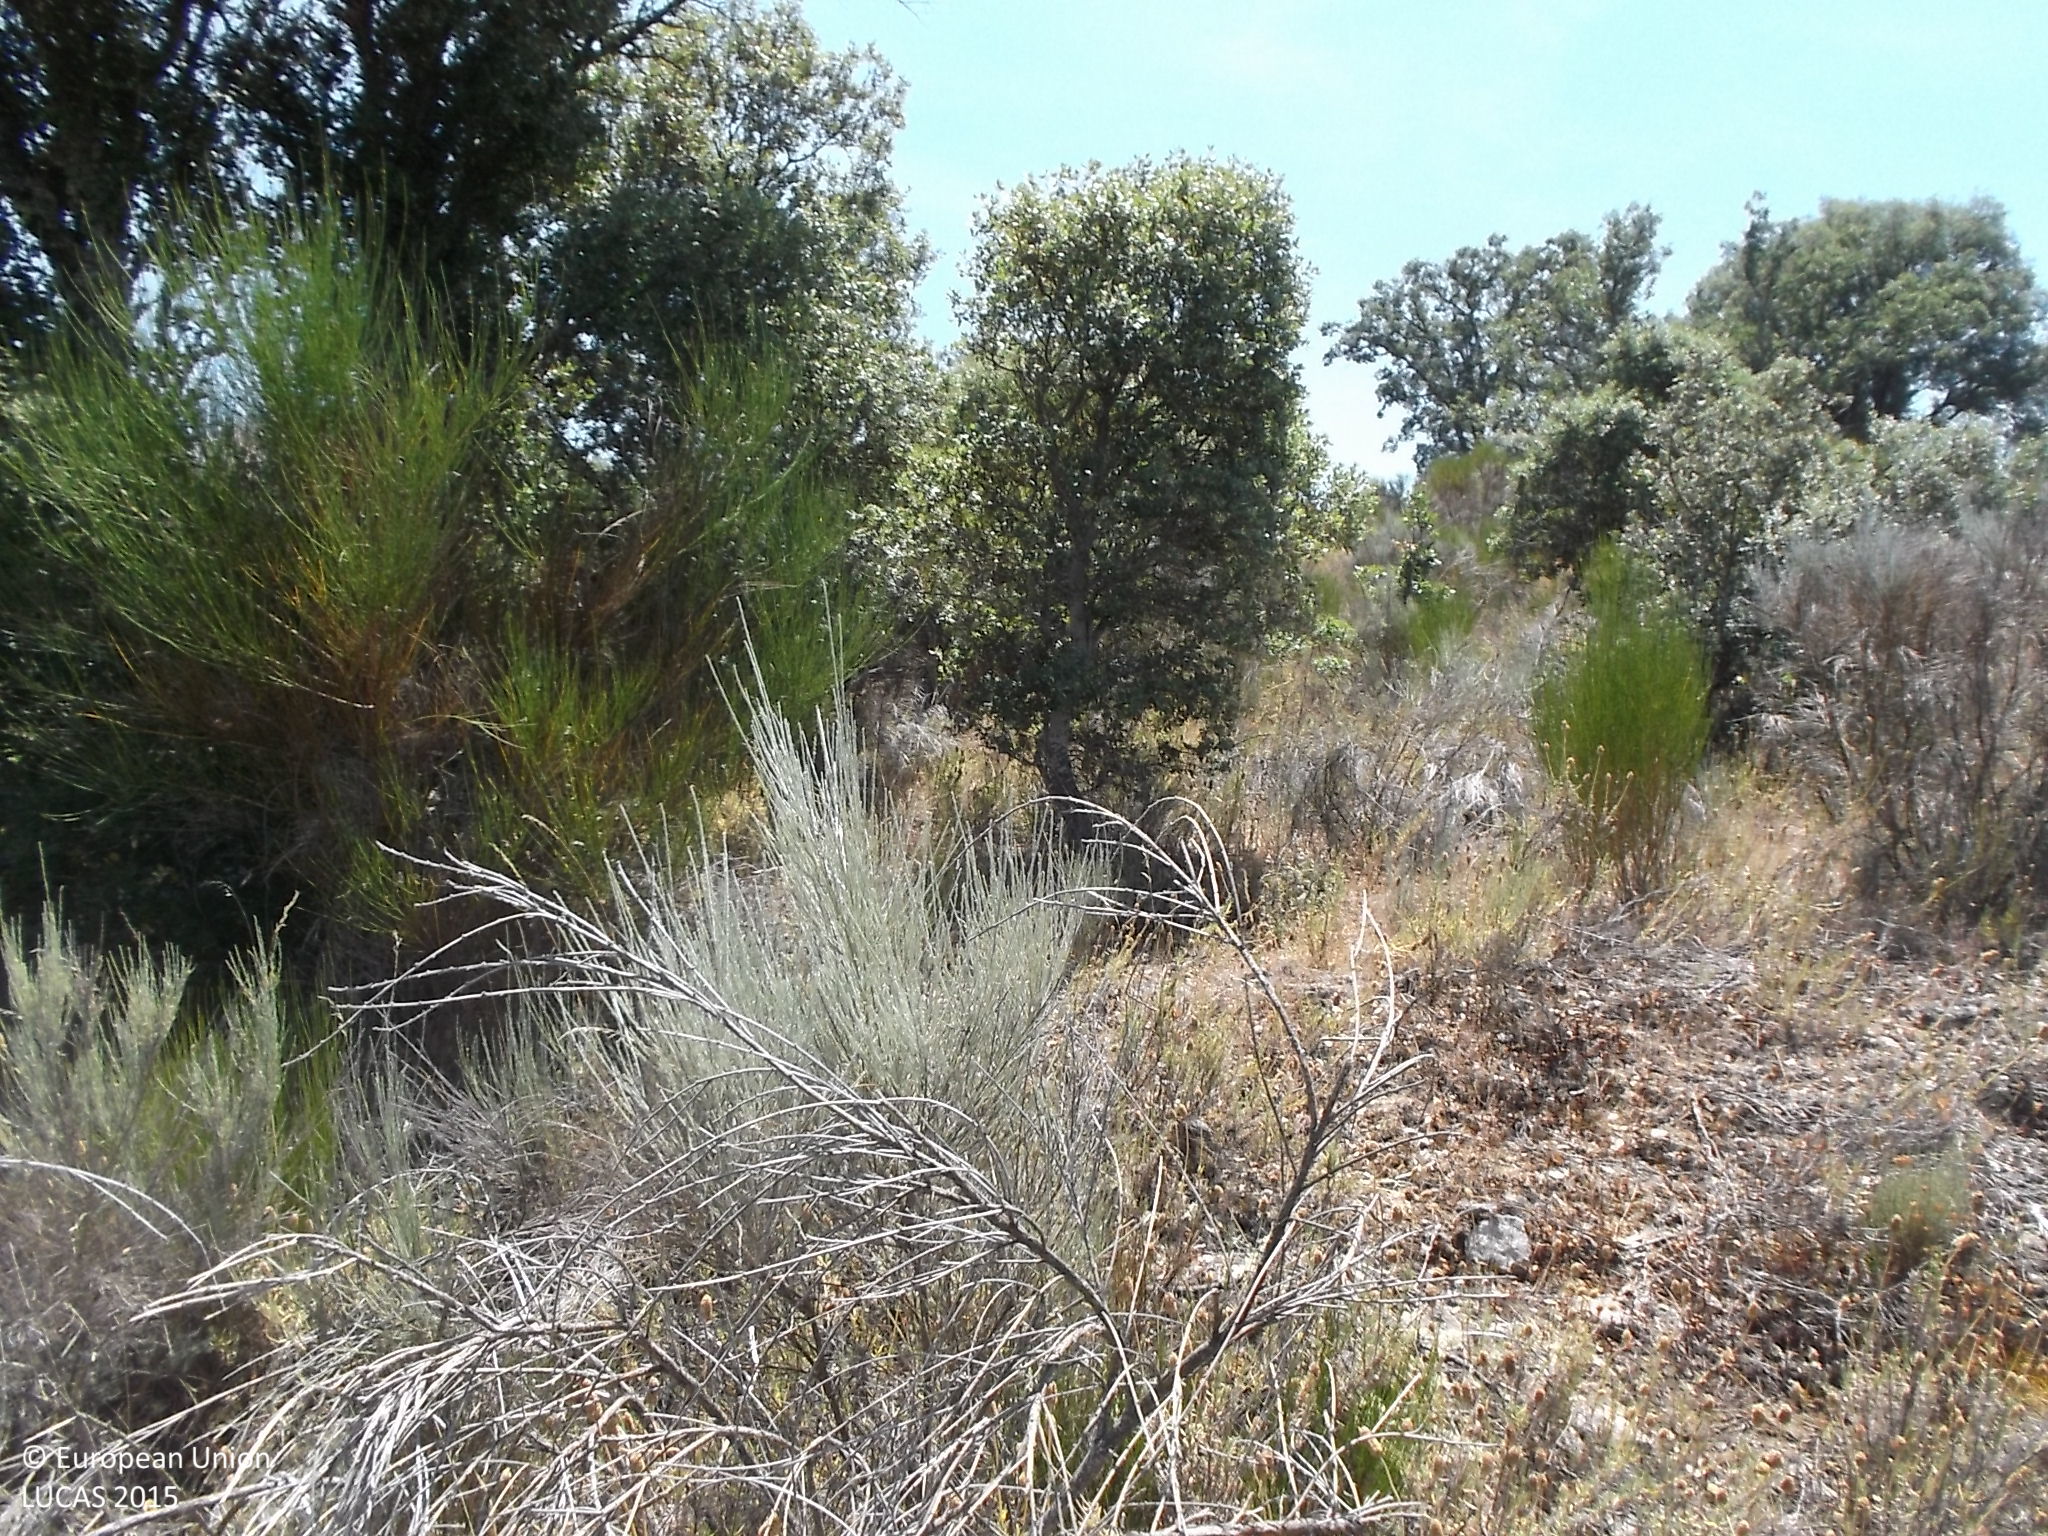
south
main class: Shrubland
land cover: Shrubland with sparse tree cover
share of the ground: > 75 %
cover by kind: shrubs 80 %, herbaceous plants 15 %, broadleaved forest trees 5 %
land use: Semi-natural and natural areas not in use
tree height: < 5 m
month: July
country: ES
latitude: 41.2712
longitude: -6.3917
